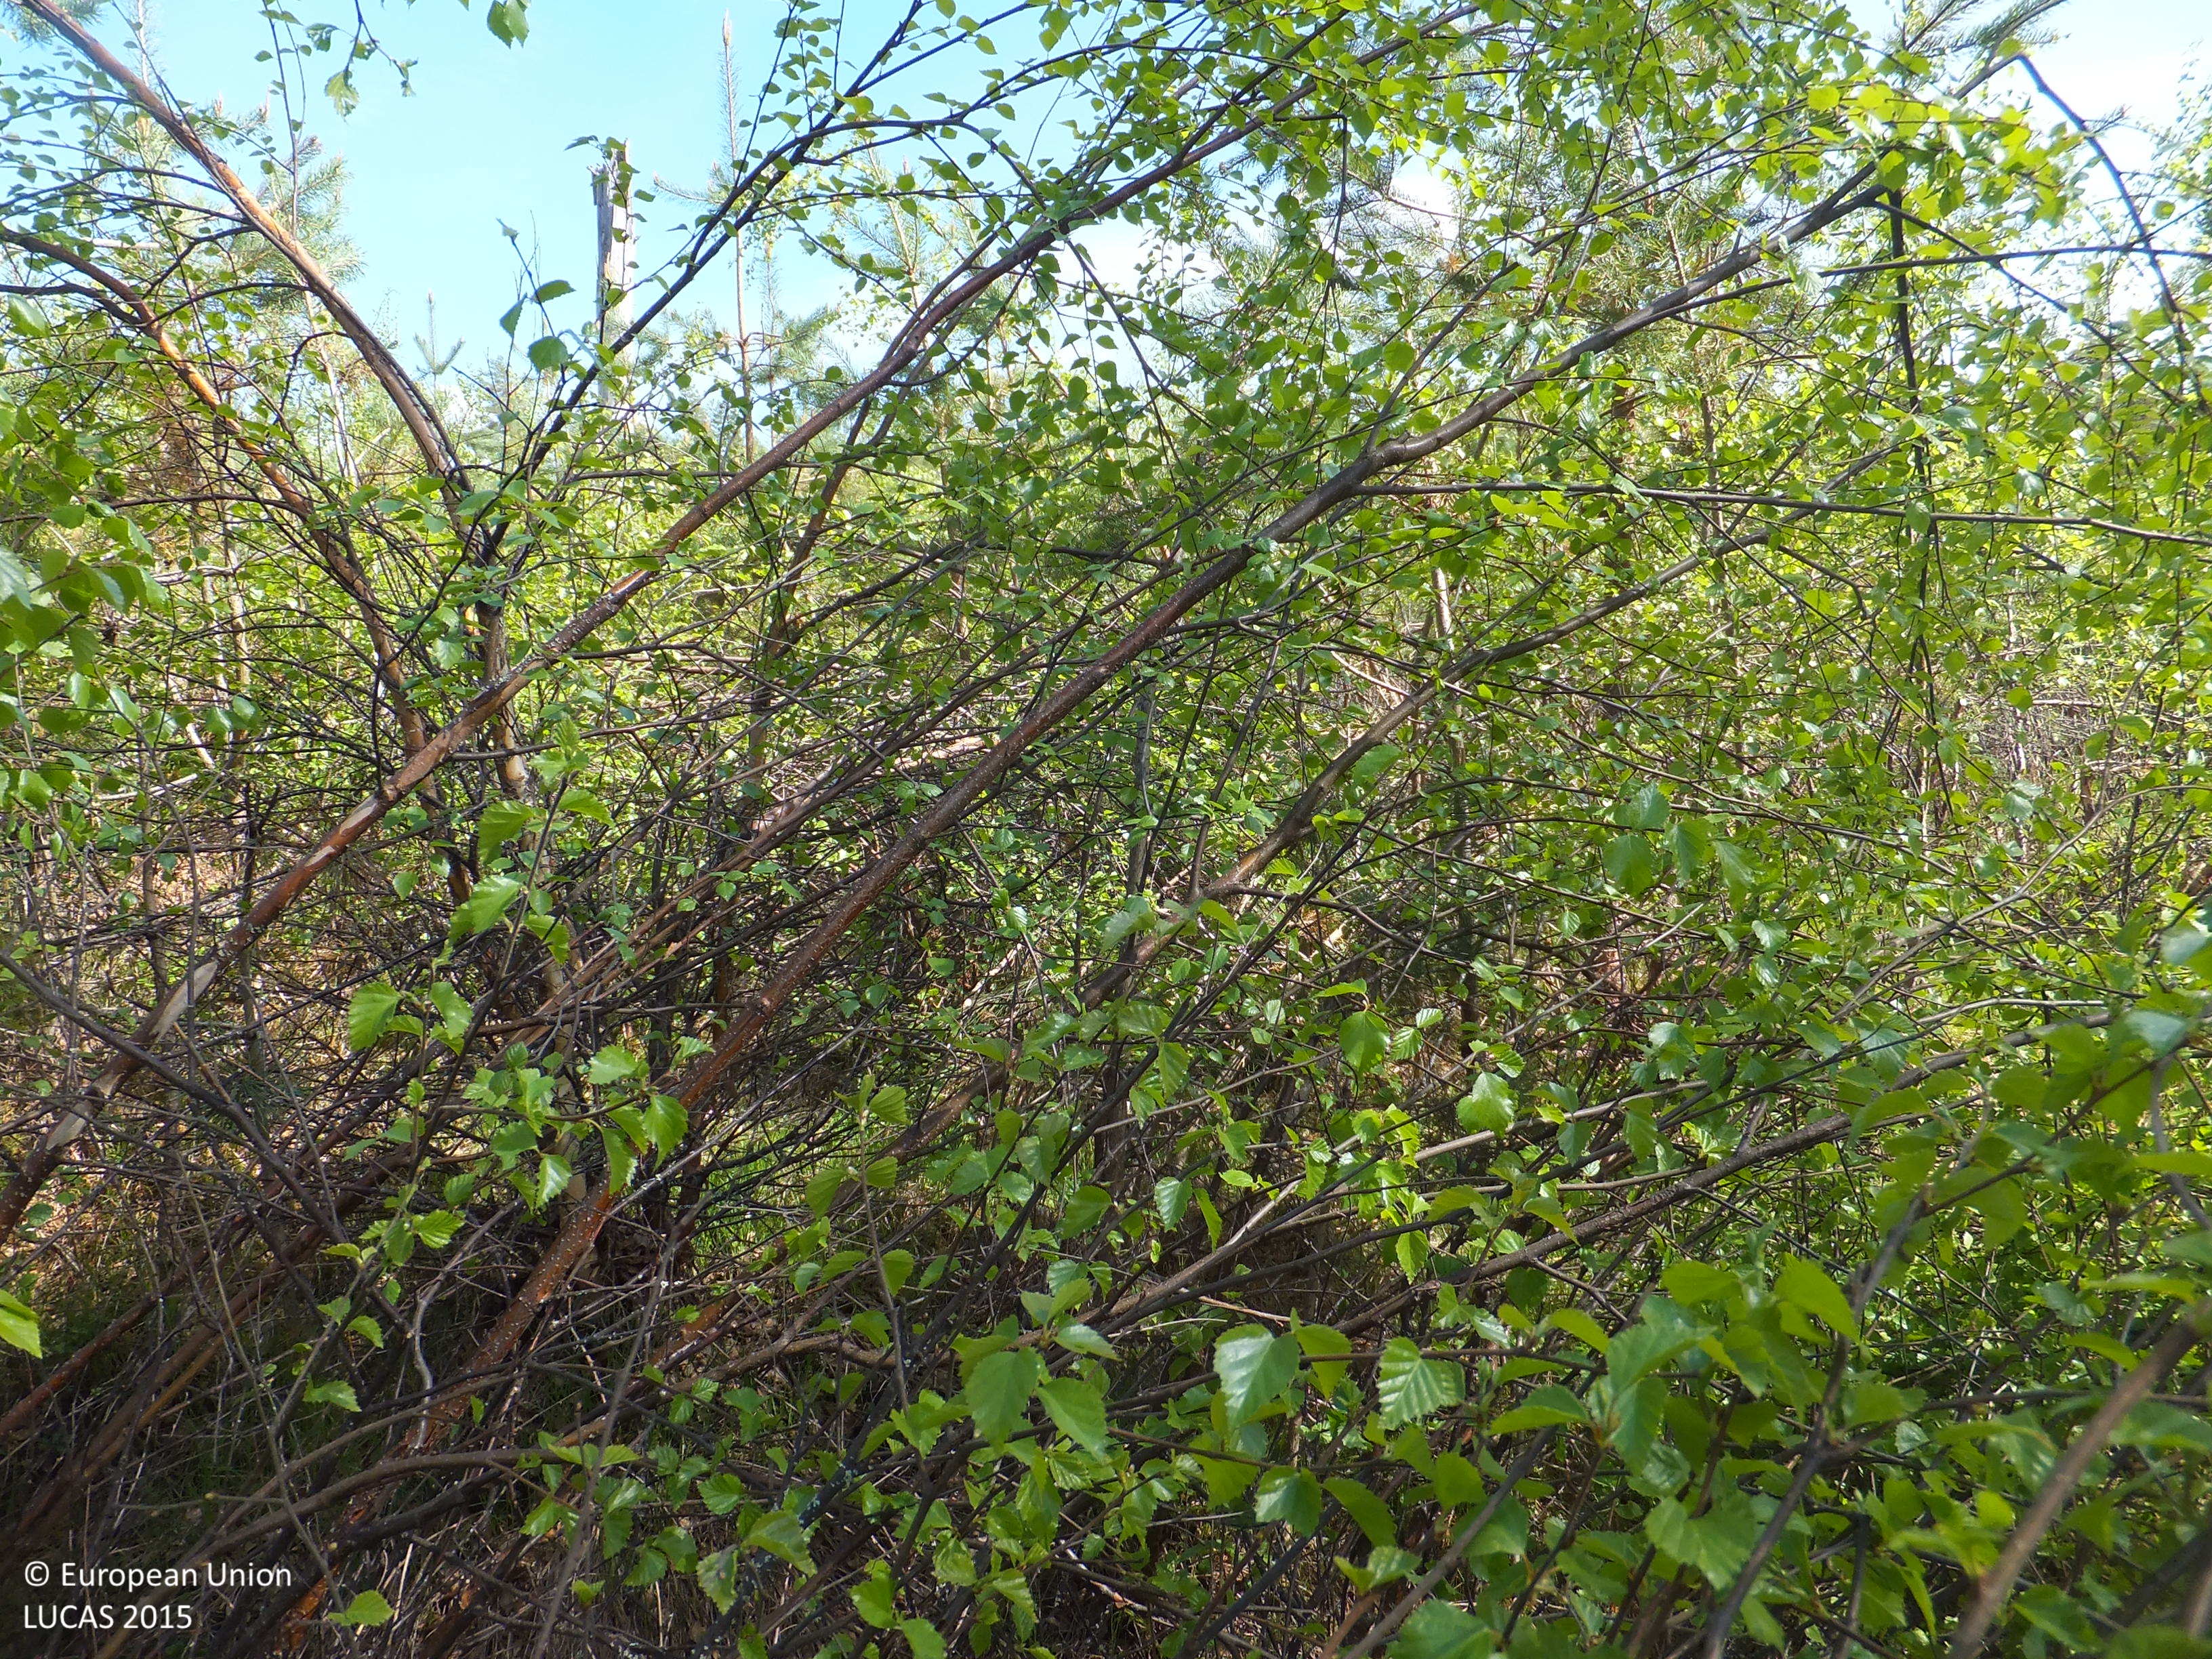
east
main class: Woodland
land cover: Pine dominated mixed woodland
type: boreal forest
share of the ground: > 75 %
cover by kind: broadleaved forest trees 70 %, coniferous forest trees 30 %
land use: Forestry
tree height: < 5 m
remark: Clear cut
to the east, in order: Pine dominated mixed woodland; Ditches and canals; Pine dominated mixed woodland; Ditches and canals; Pine dominated coniferous woodland; Ditches and canals; Pine dominated coniferous woodland; Spruce dominated mixed woodland; Ditches and canals; Spruce dominated coniferous woodland; Ditches and canals; Pine dominated coniferous woodland; Ditches and canals; Pine dominated coniferous woodland; Ditches and canals; Pine dominated coniferous woodland
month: June
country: FI
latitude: 63.4854
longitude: 22.8822
